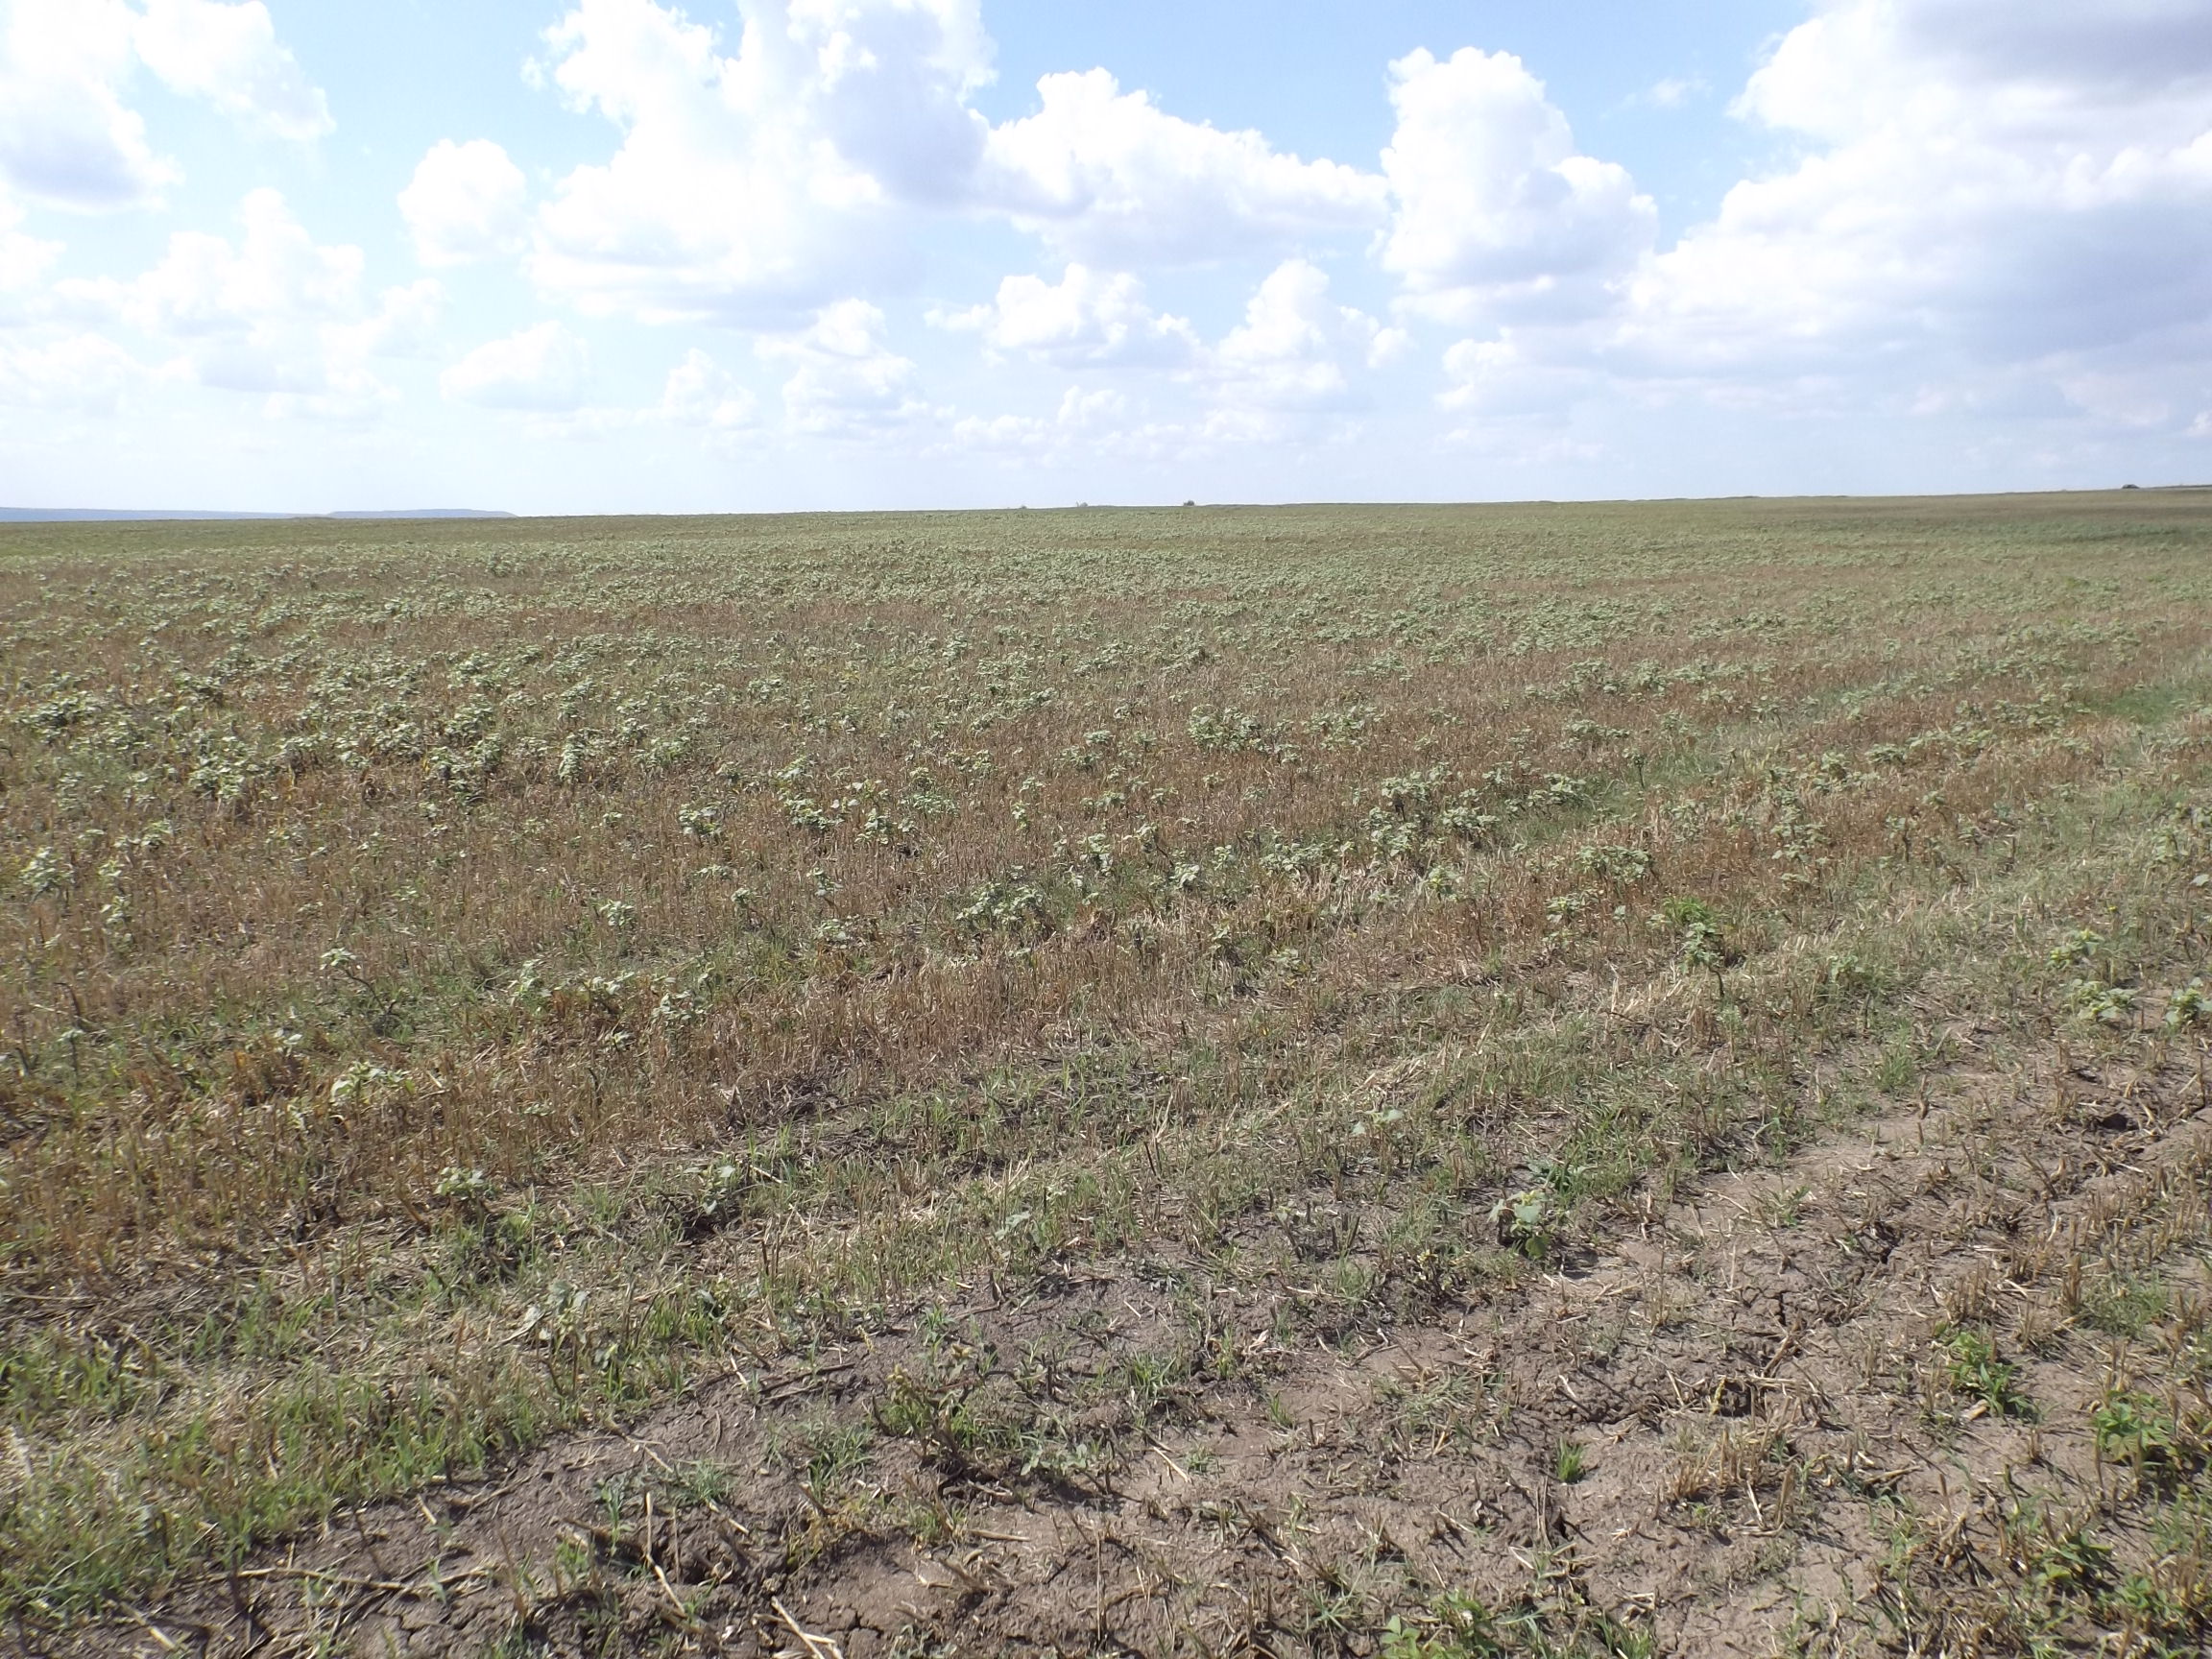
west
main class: Cropland
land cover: Other cereals
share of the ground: 10 - 25 %
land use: Agriculture (excluding fallow land and kitchen gardens)
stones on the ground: < 10 %
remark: Harvested field
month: September
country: BG
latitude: 43.2839
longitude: 27.5428
